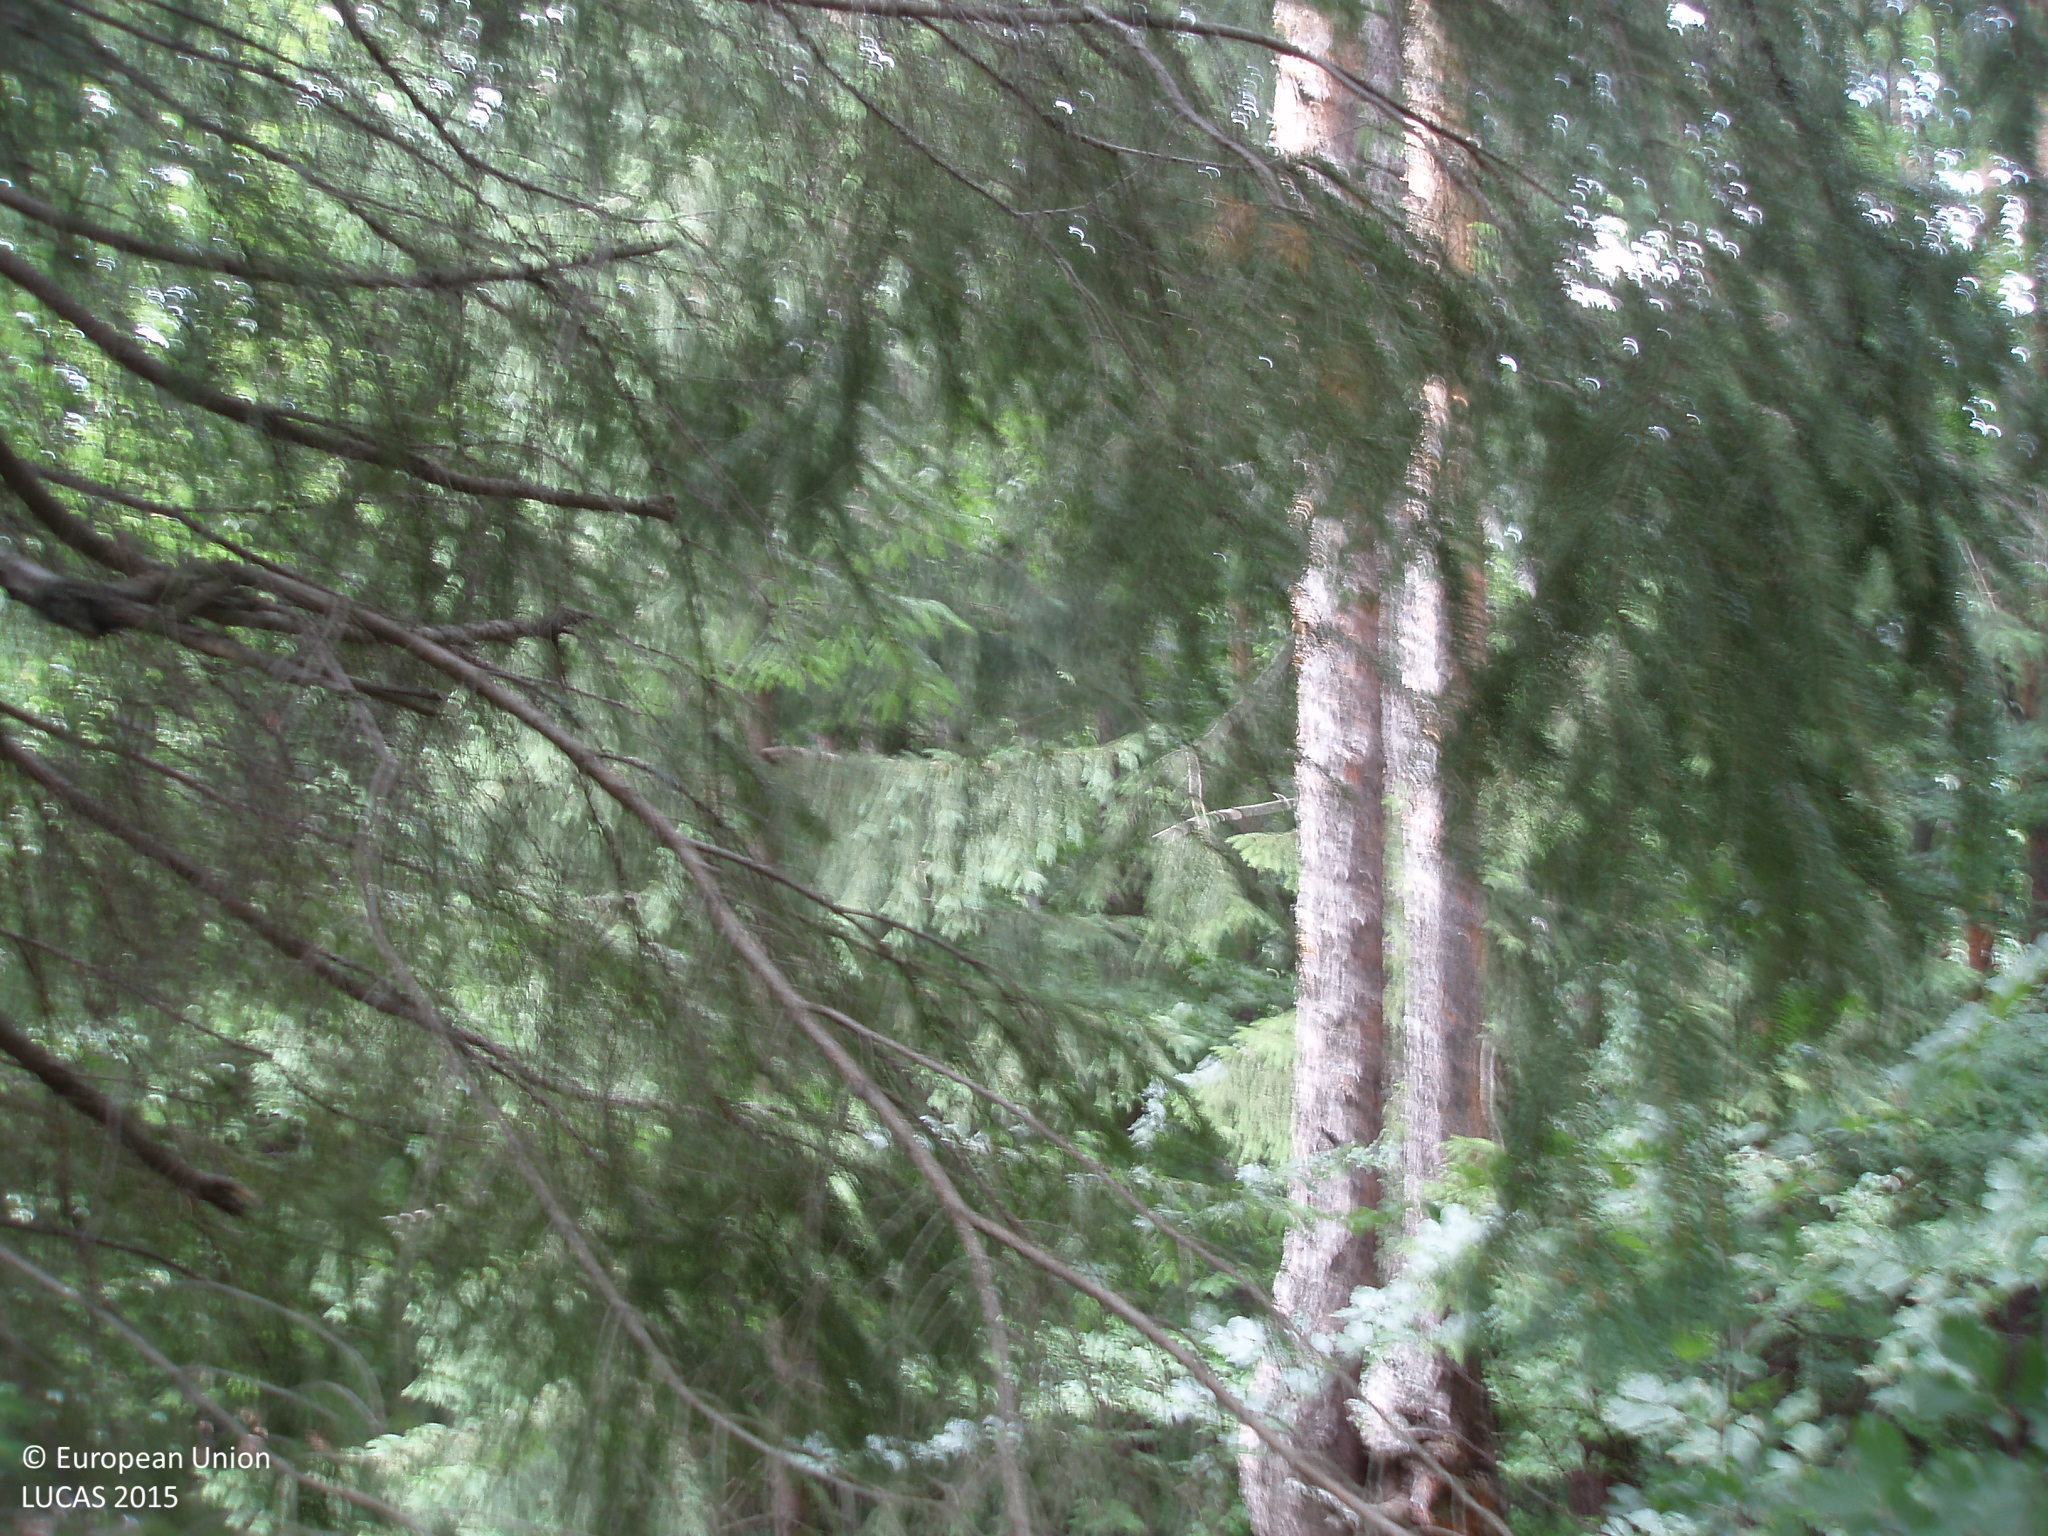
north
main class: Woodland
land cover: Pine dominated mixed woodland
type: hemiboreal forest and nemoral coniferous forest and mixed broadleaved-coniferous forest
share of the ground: > 75 %
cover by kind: coniferous forest trees 75 %, broadleaved forest trees 25 %
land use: Forestry
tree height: > 5 m
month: July
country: BG
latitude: 42.0458
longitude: 23.8444
